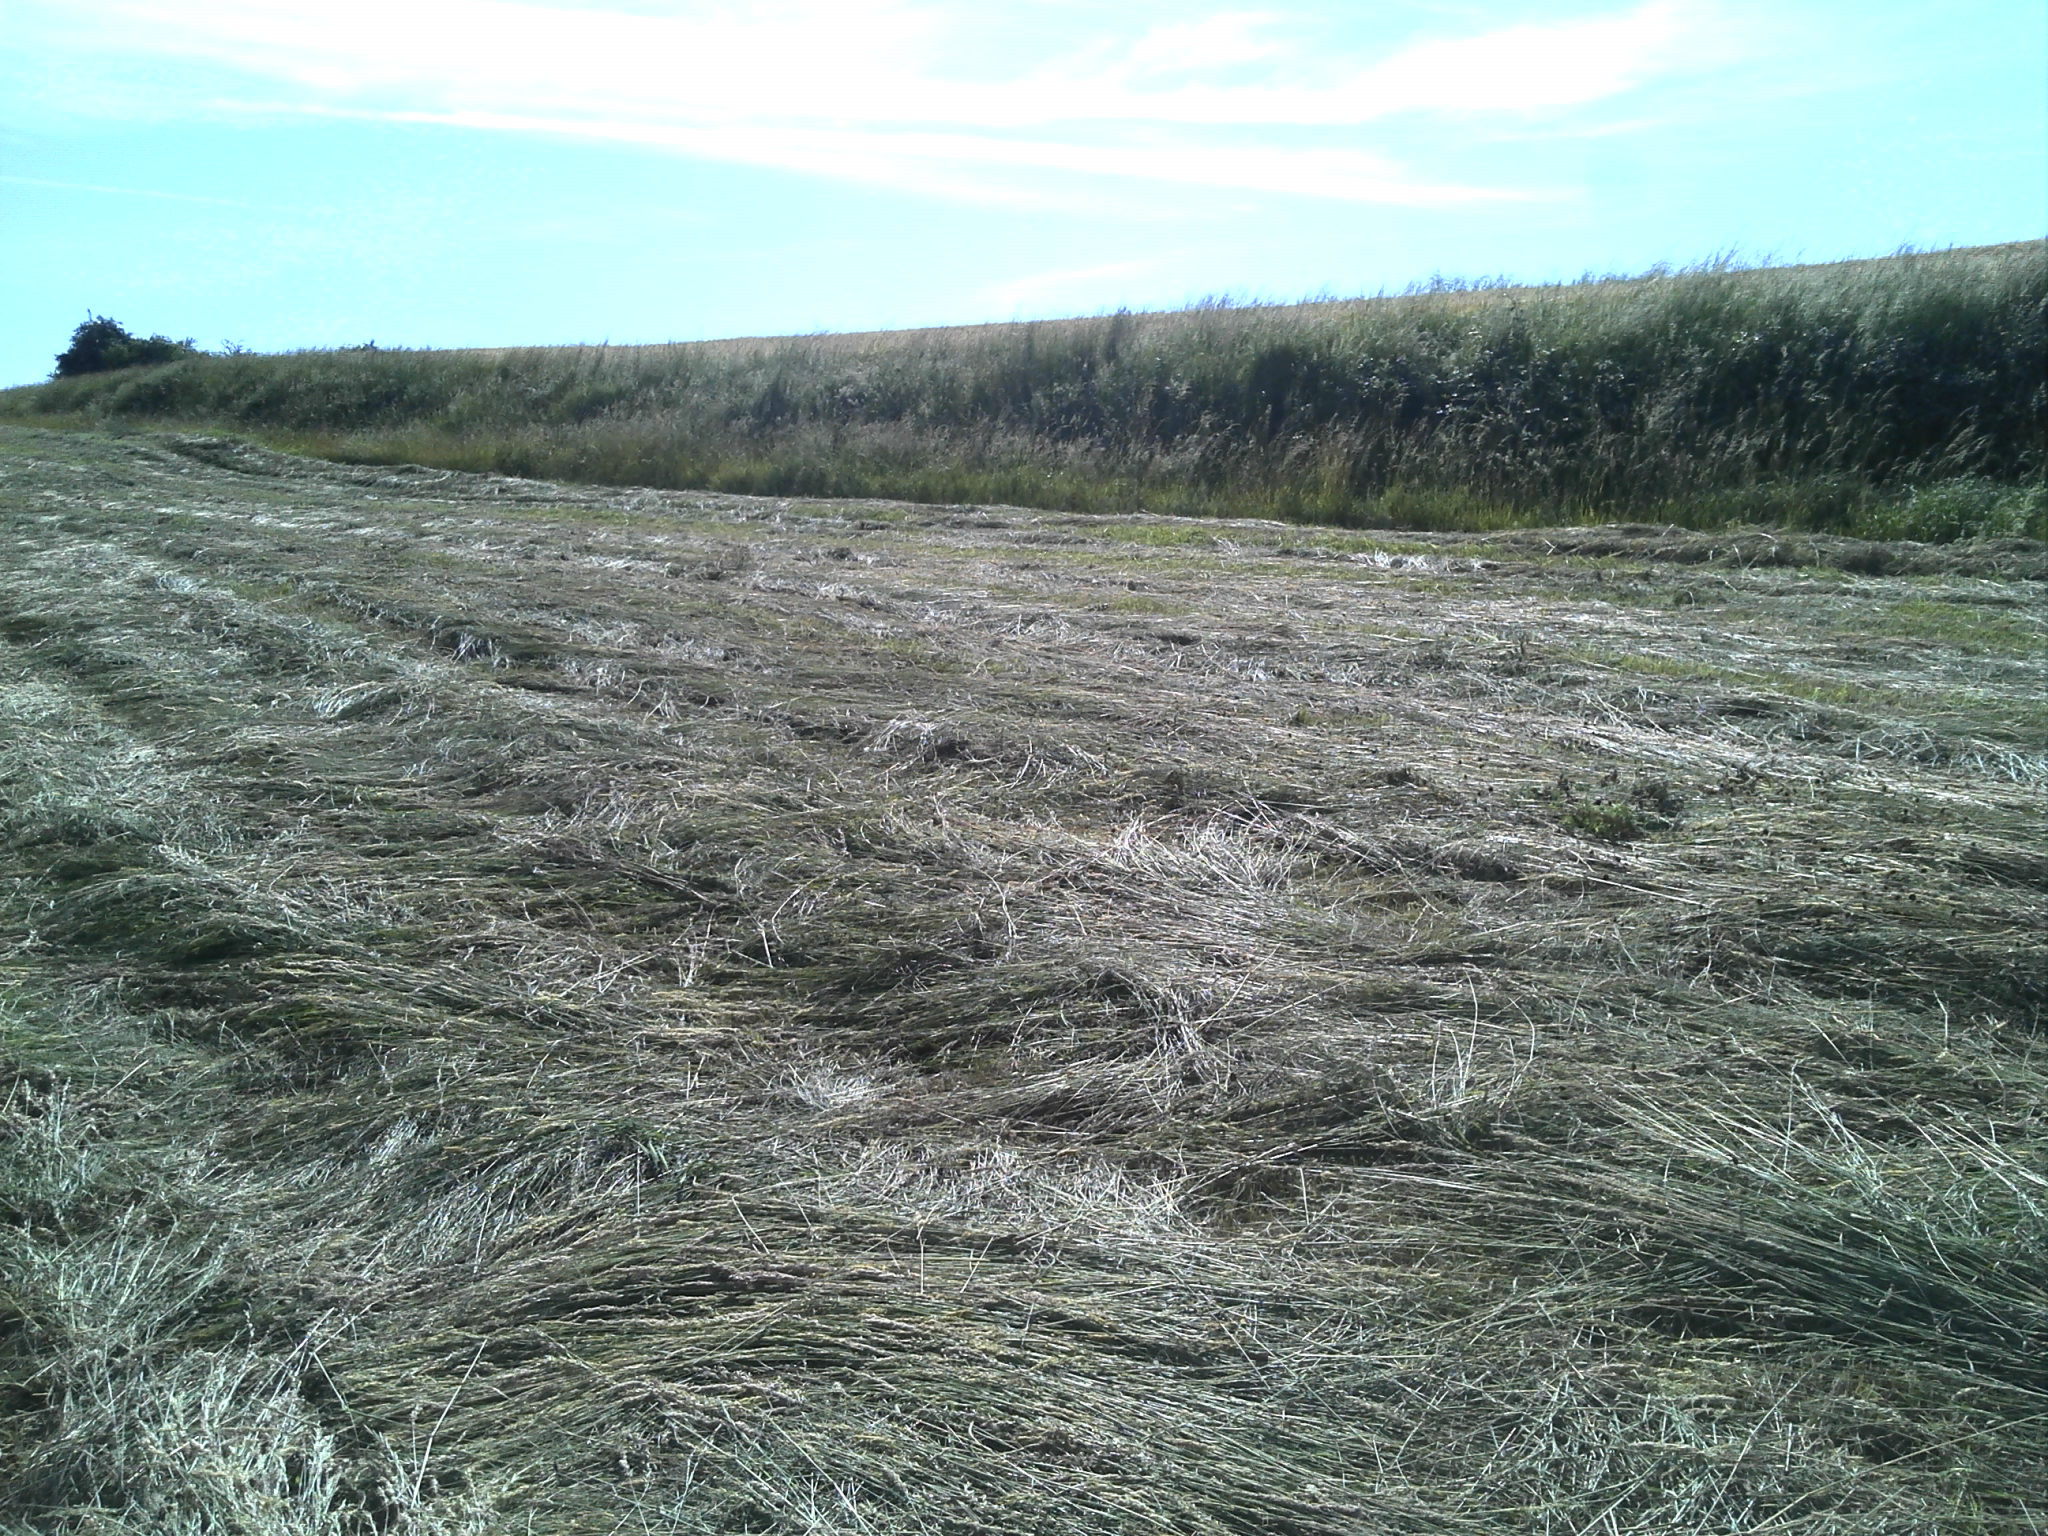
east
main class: Grassland
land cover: Grassland without tree/shrub cover
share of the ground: > 75 %
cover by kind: herbaceous plants 100 %
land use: Agriculture (excluding fallow land and kitchen gardens)
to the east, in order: Grassland without tree/shrub cover; Grass margins; Tracks; Grass margins; Ditches and canals; Grass margins; Barley; Tracks; Barley
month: June
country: FR
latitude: 47.2050
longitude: 1.4719
